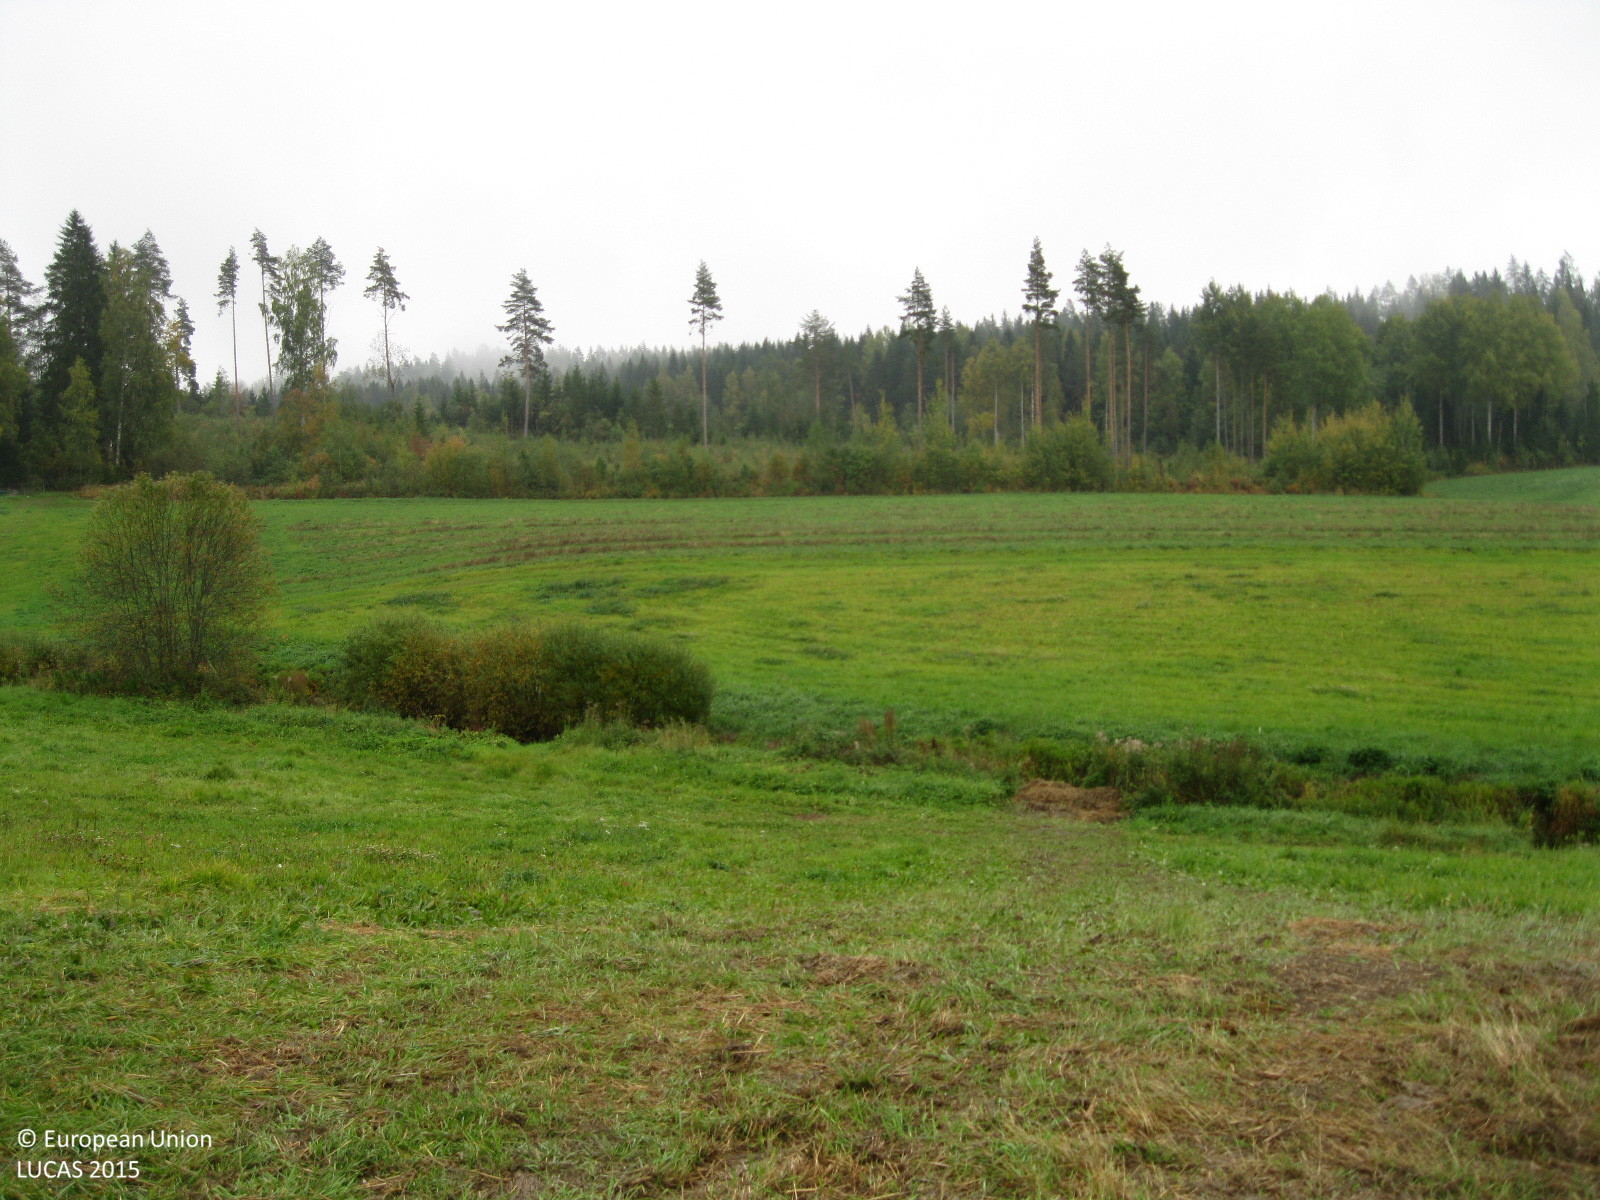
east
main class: Cropland
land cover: Temporary grasslands
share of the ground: > 75 %
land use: Agriculture (excluding fallow land and kitchen gardens)
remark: Harvested field
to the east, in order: Temporary grasslands; Grass margins; Rivers and streams; Single bushes/trees; Temporary grasslands; Broadleaved woodland
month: September
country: FI
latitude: 60.9087
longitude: 25.0690
